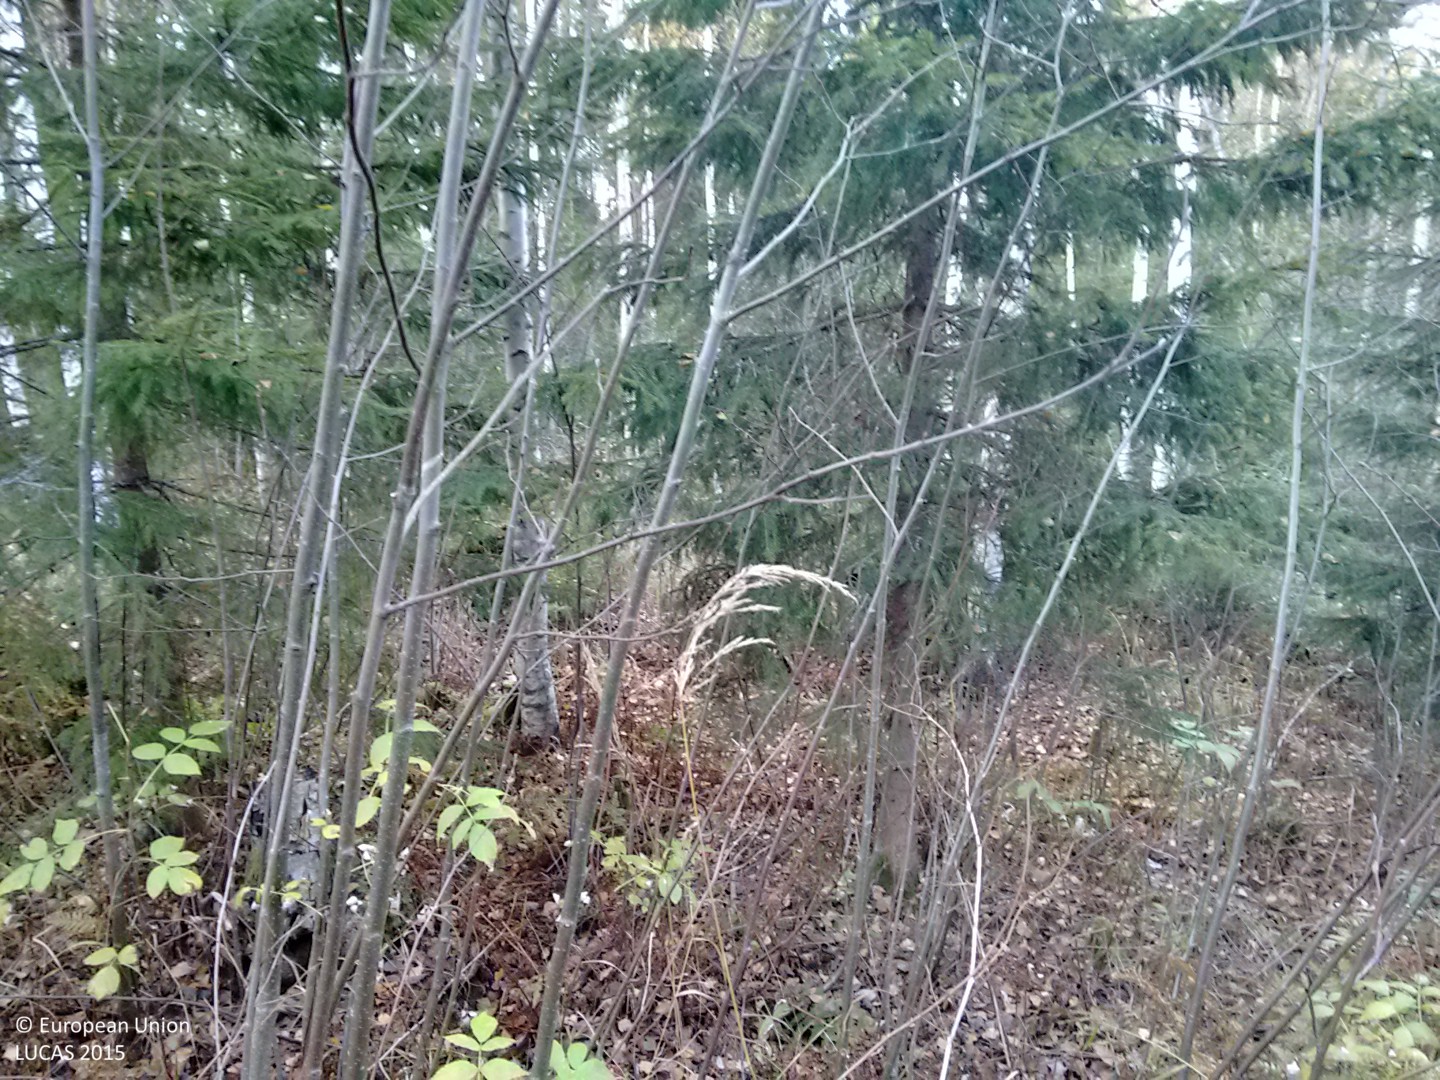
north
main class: Woodland
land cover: Spruce dominated mixed woodland
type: boreal forest
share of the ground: > 75 %
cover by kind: broadleaved forest trees 45 %, coniferous forest trees 40 %, shrubs 10 %, herbaceous plants 5 %
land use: Forestry
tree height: > 5 m
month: October
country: FI
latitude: 62.8430
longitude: 26.1292
